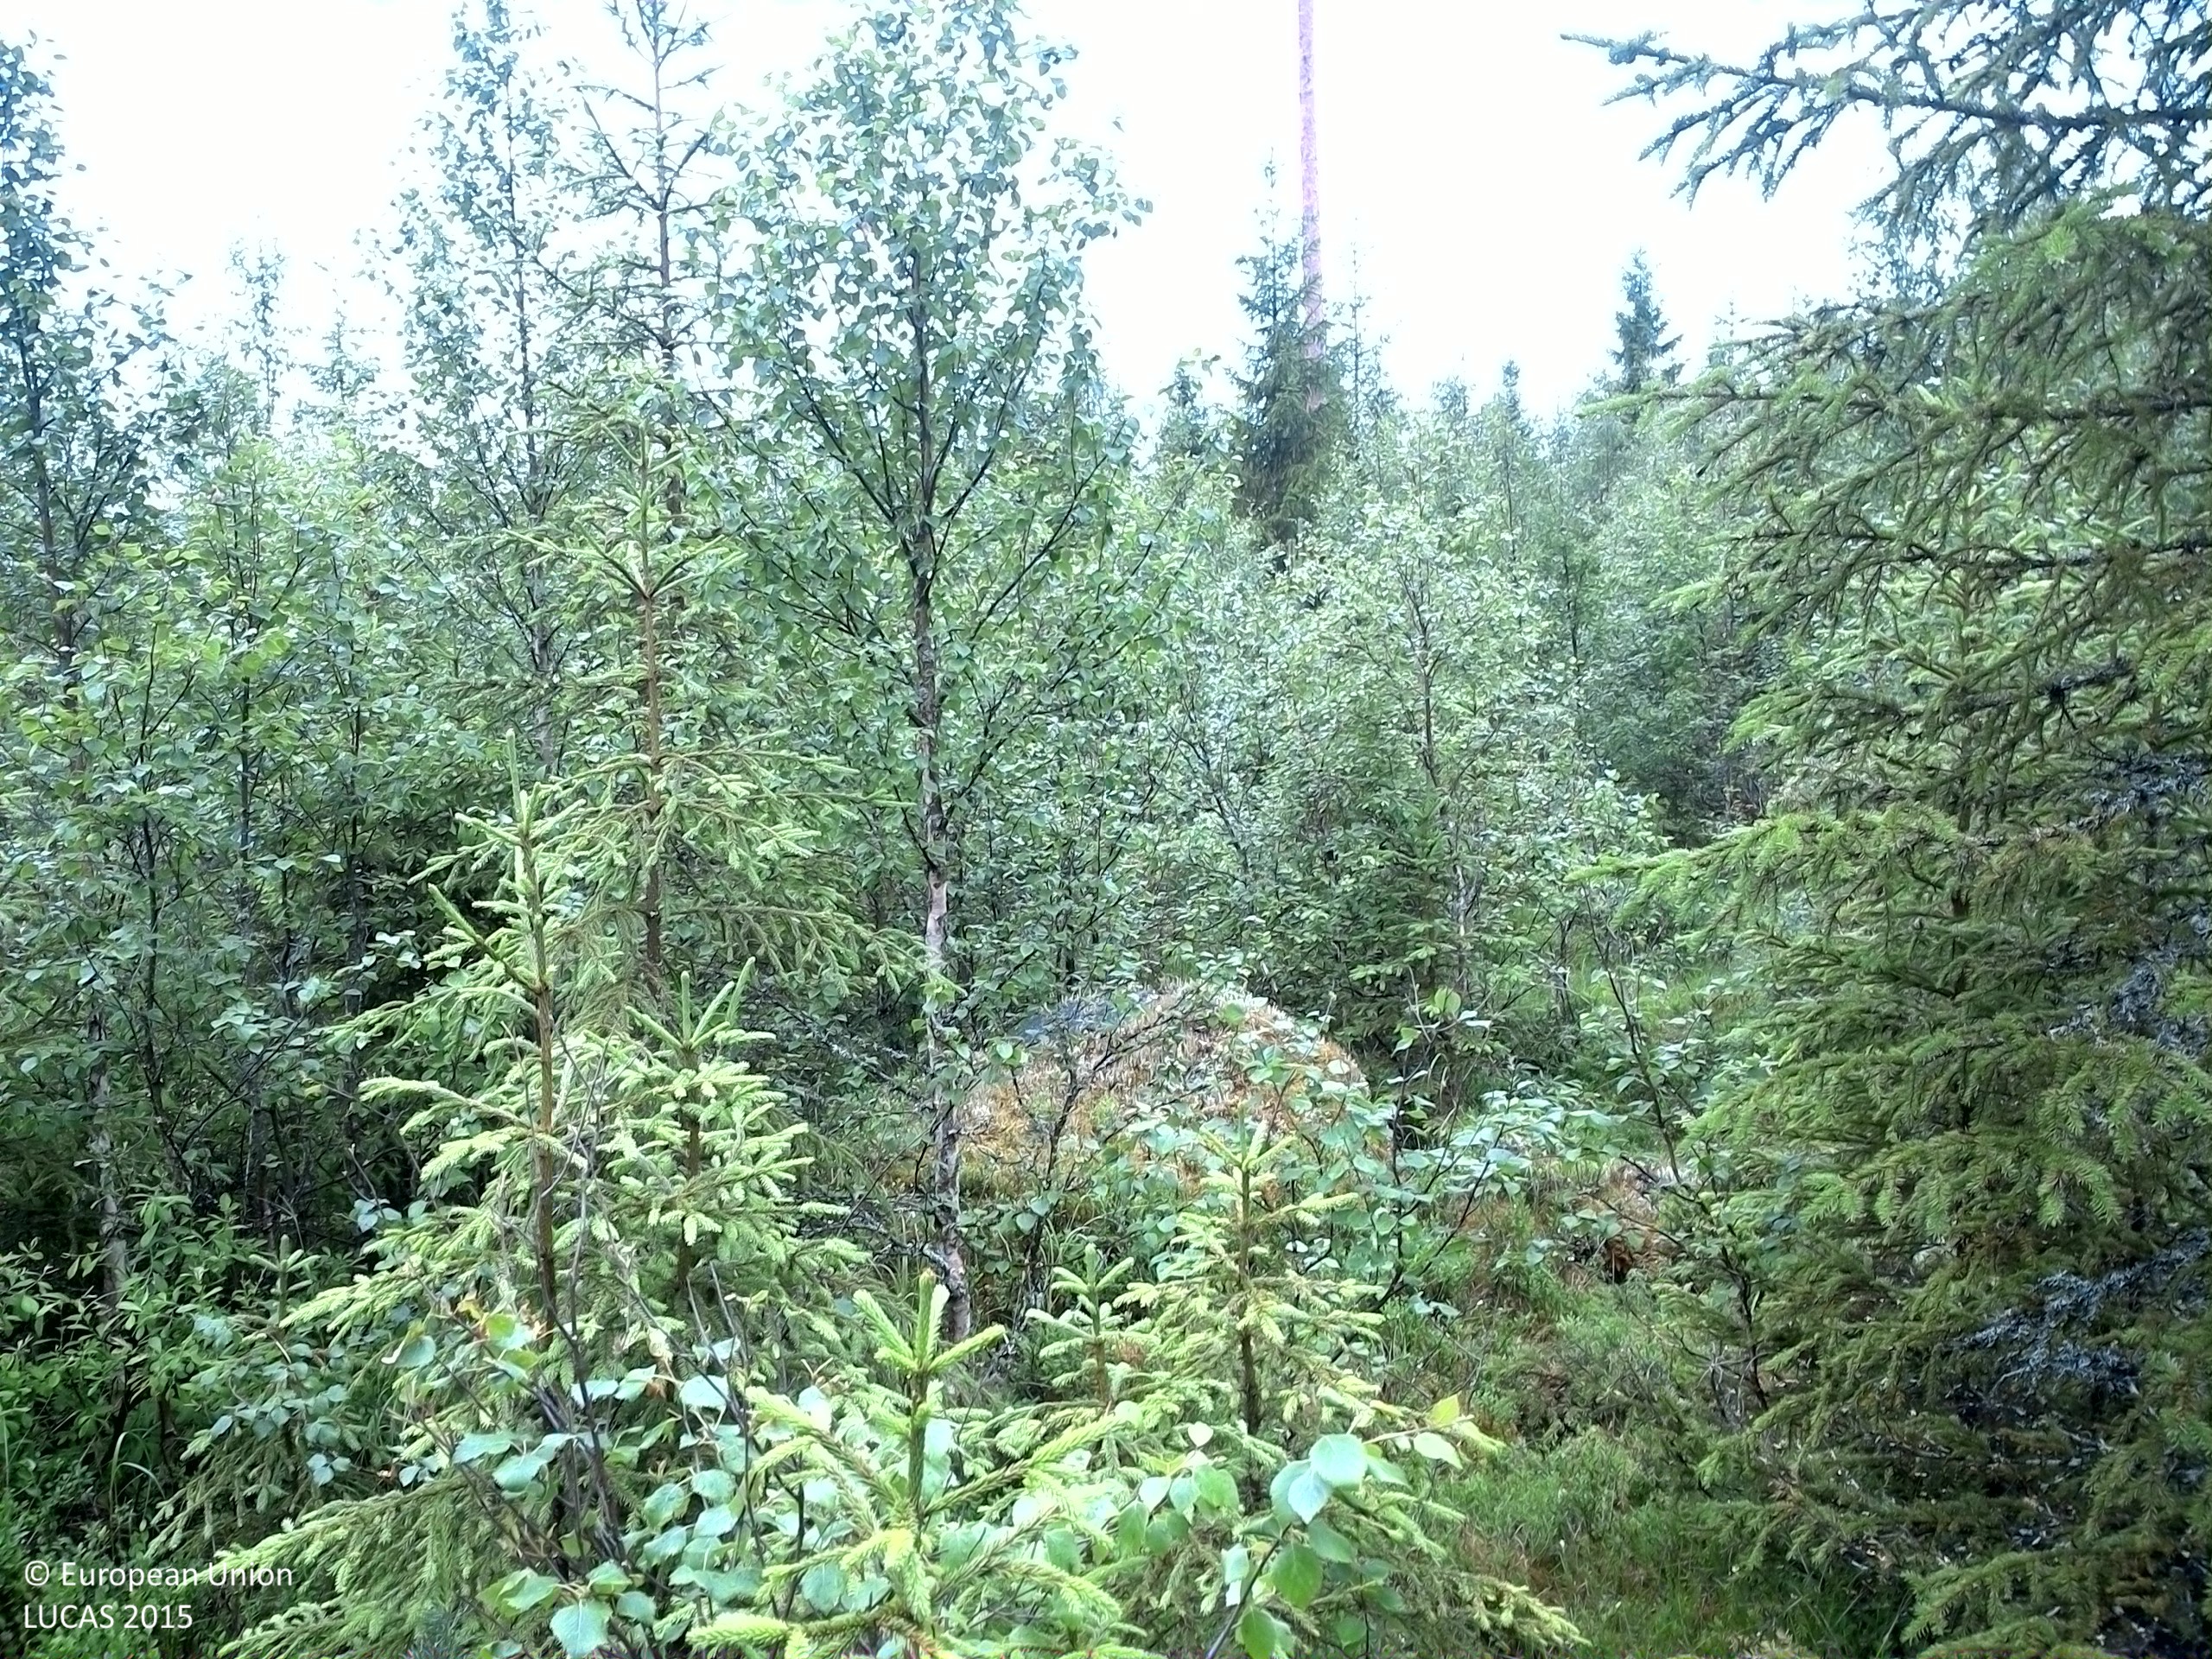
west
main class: Woodland
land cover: Spruce dominated mixed woodland
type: boreal forest
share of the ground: > 75 %
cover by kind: coniferous forest trees 55 %, broadleaved forest trees 30 %, shrubs 15 %
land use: Forestry
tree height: < 5 m
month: July
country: SE
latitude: 63.6601
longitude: 18.5199
